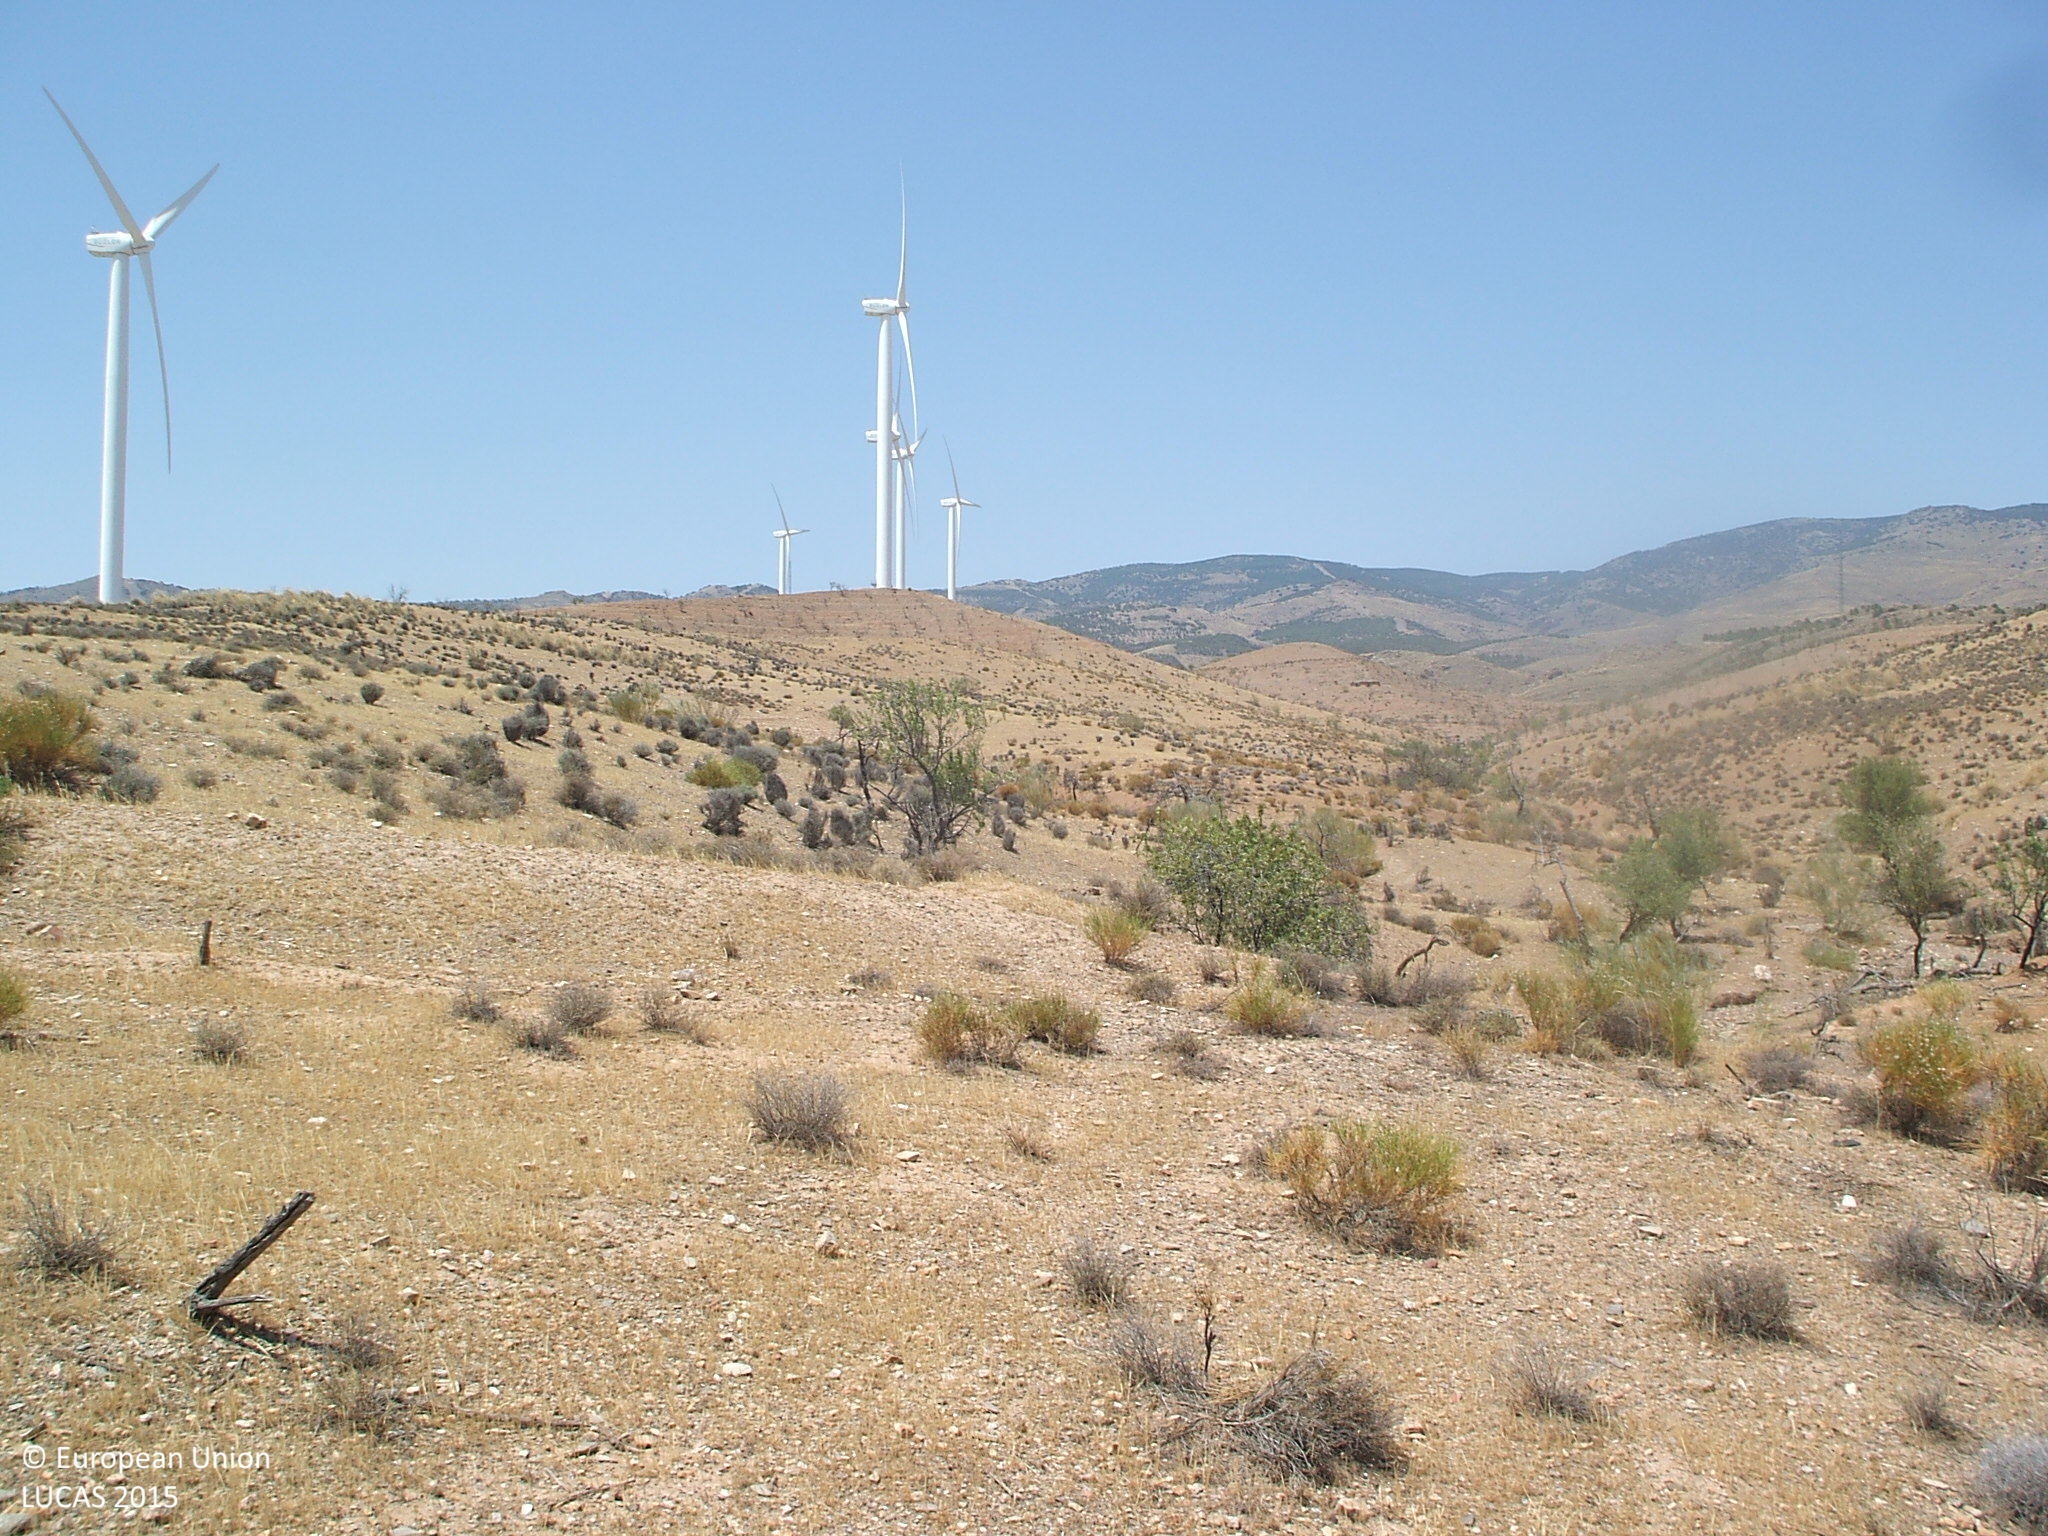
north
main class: Shrubland
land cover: Shrubland without tree cover
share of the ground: 10 - 25 %
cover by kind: herbaceous plants 40 %, consolidated bare surface 40 %, shrubs 20 %
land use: Semi-natural and natural areas not in use
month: June
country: ES
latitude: 37.1737
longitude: -2.7881
